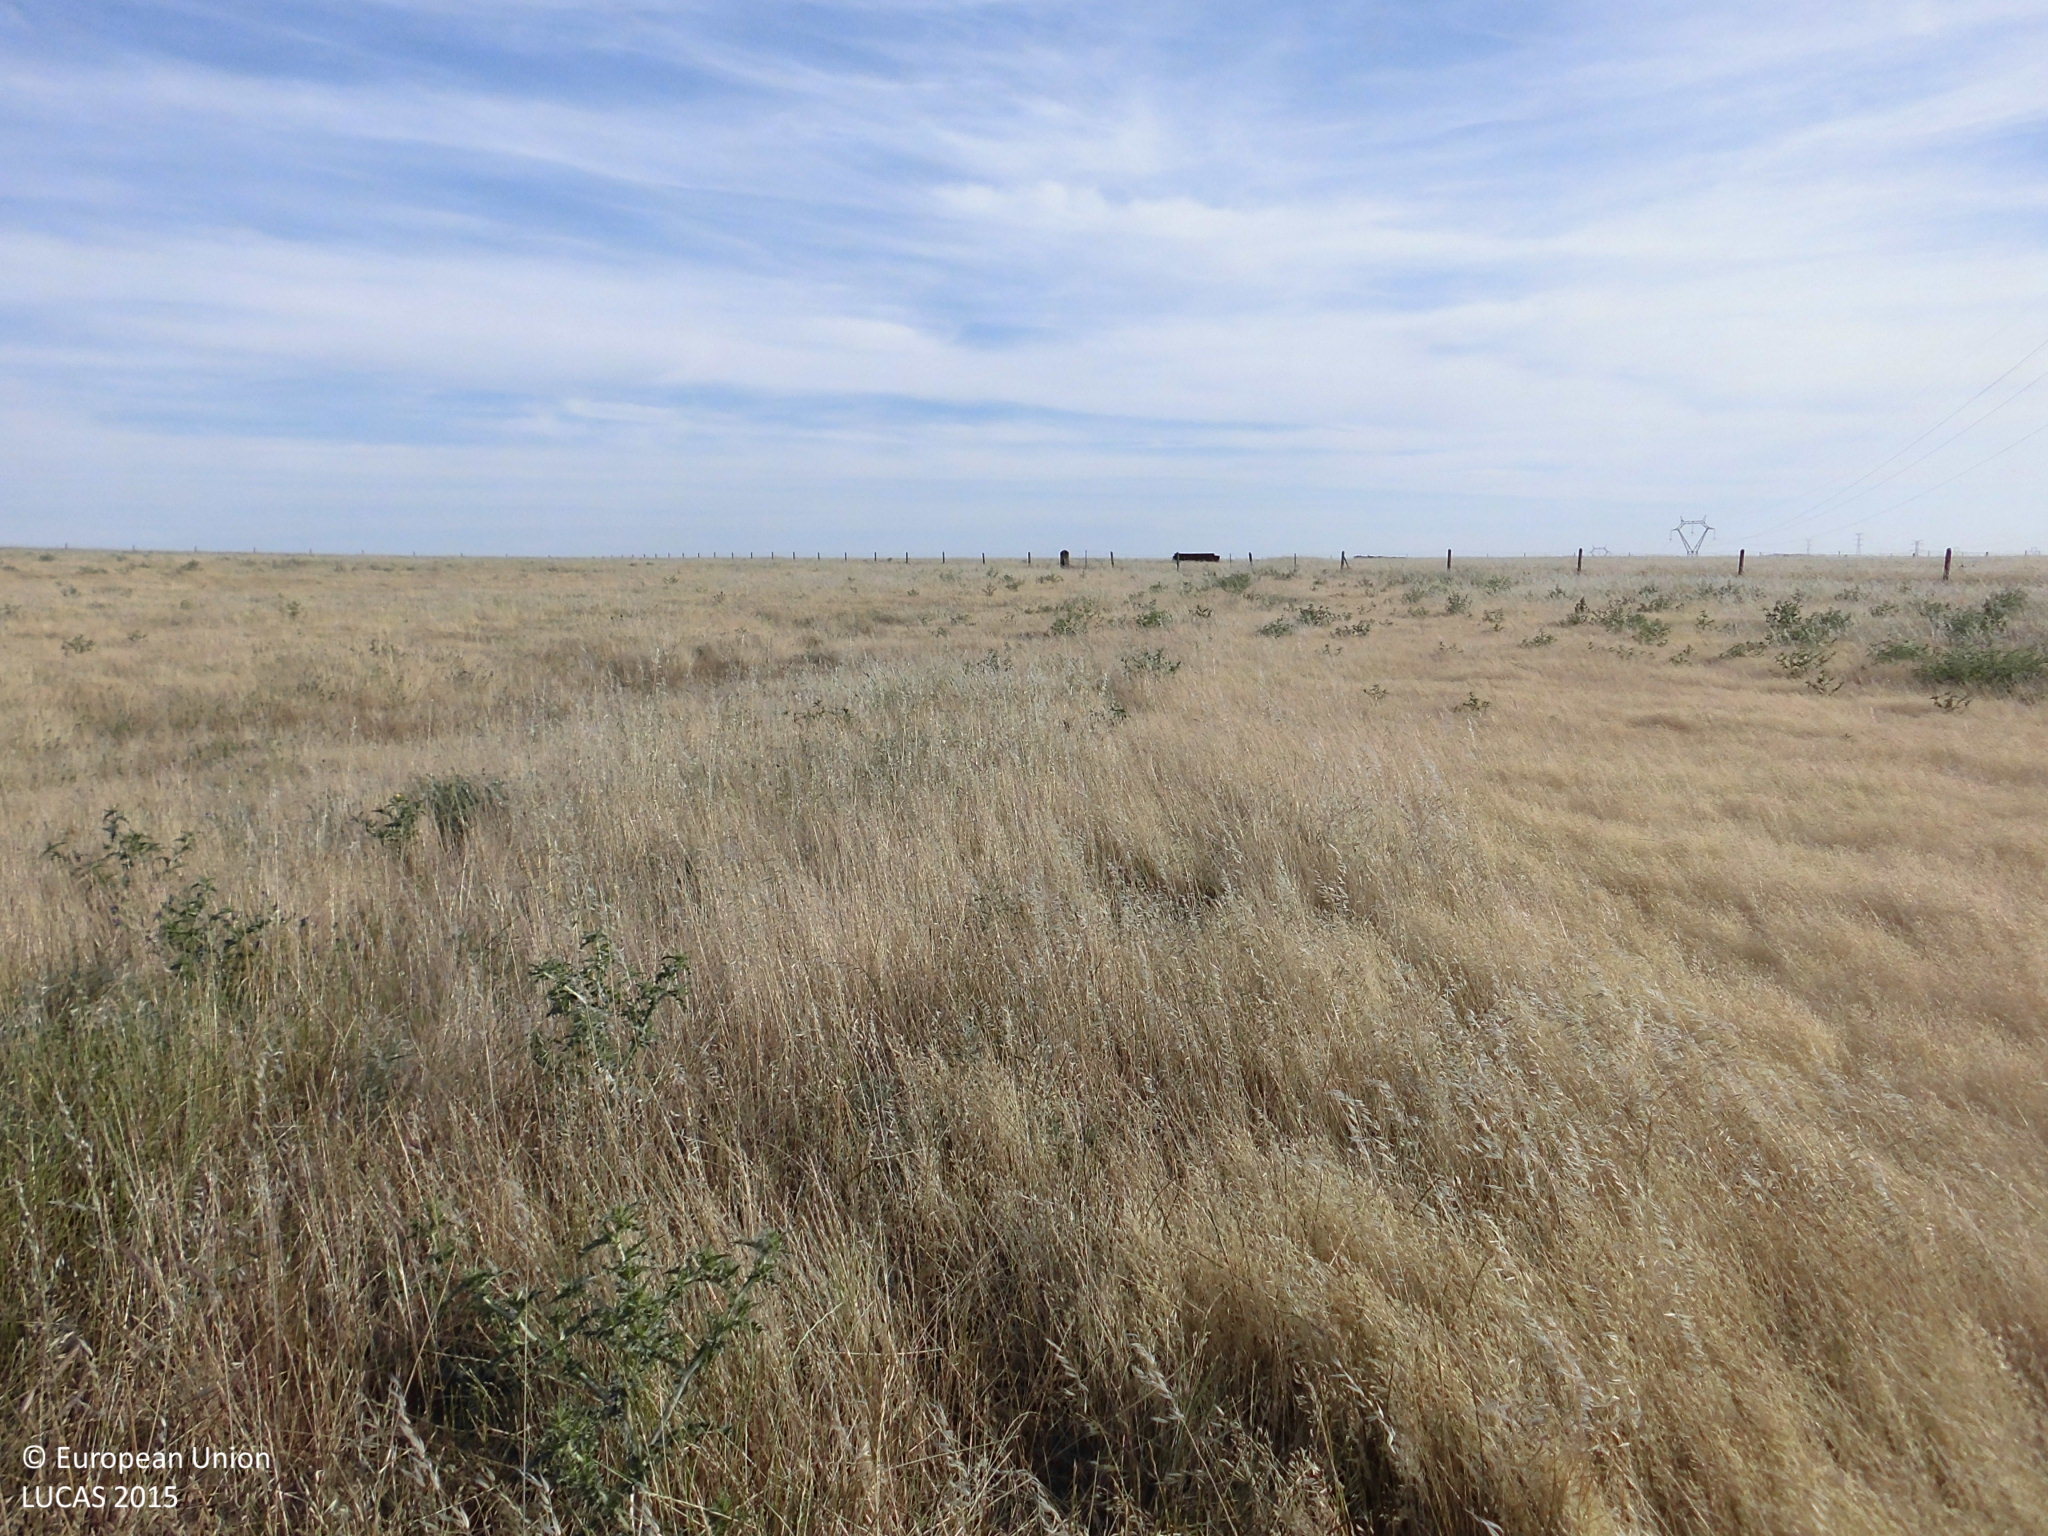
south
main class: Grassland
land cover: Grassland without tree/shrub cover
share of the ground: > 75 %
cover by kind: herbaceous plants 100 %
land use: Agriculture (excluding fallow land and kitchen gardens)
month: May
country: ES
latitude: 39.4154
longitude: -5.9360
